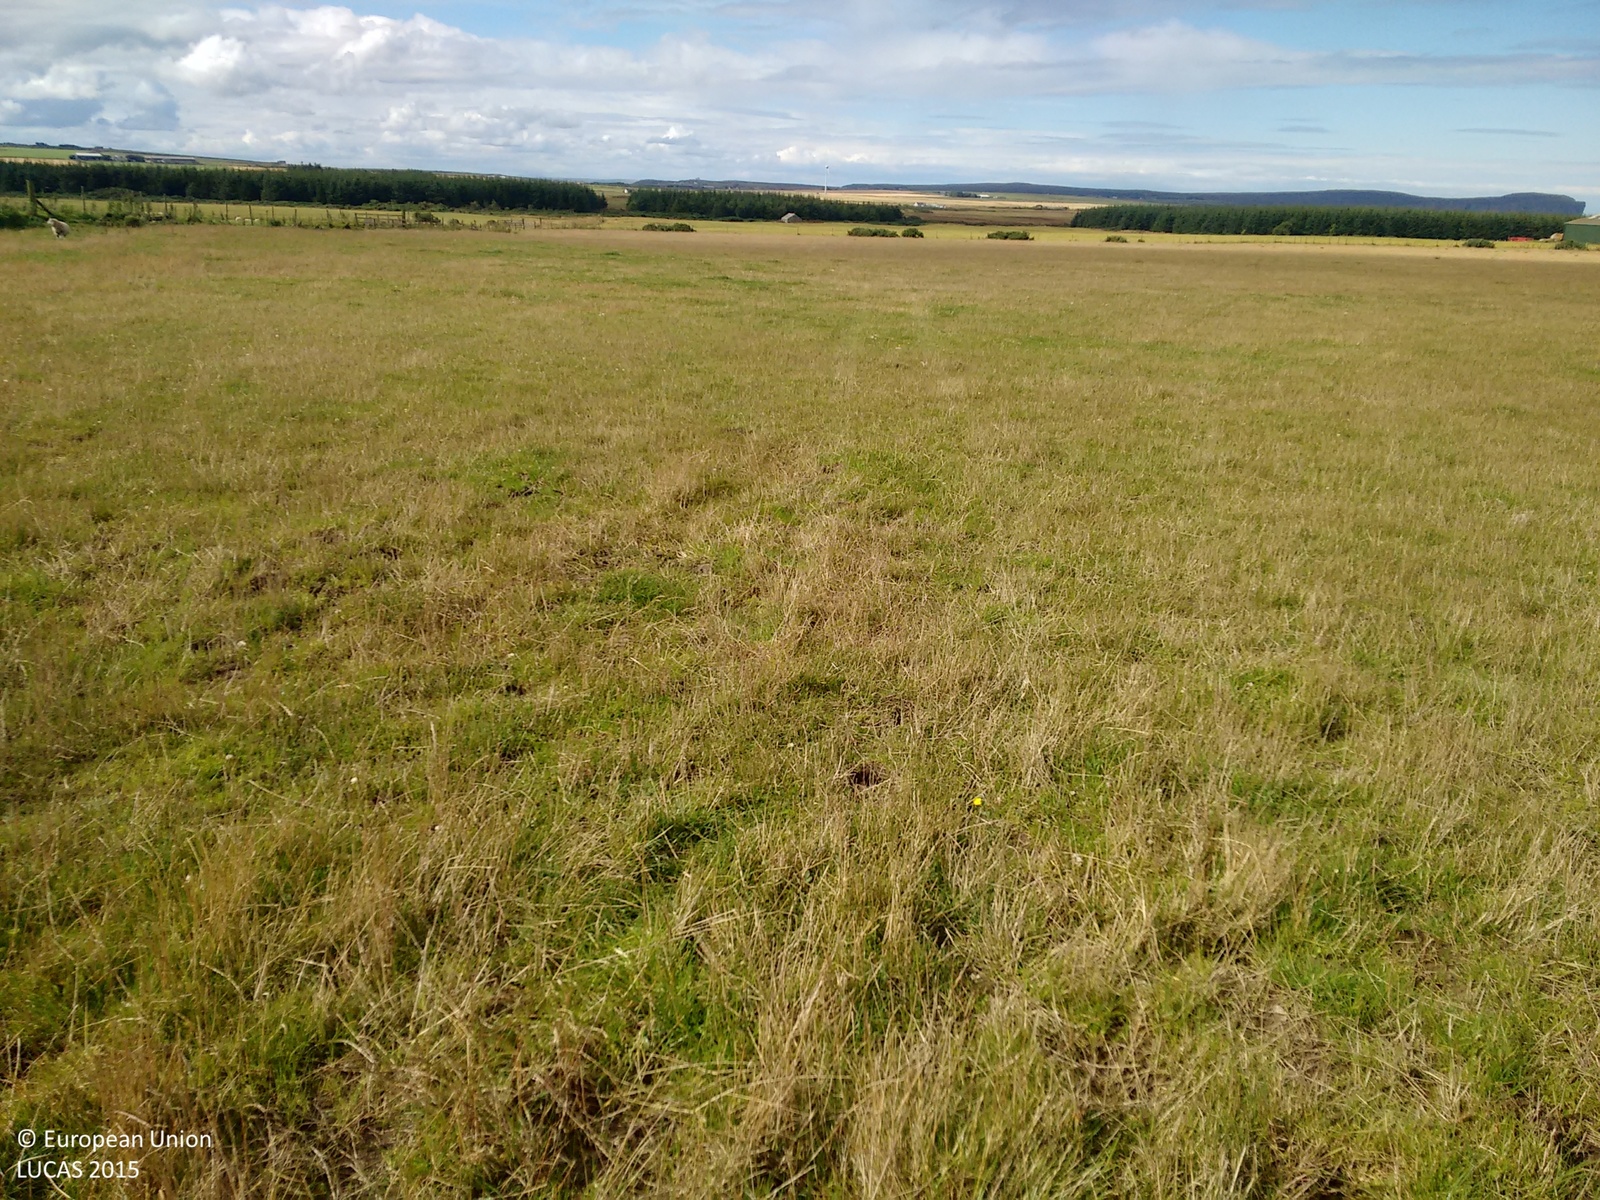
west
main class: Grassland
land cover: Grassland without tree/shrub cover
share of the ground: > 75 %
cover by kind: herbaceous plants 100 %
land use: Agriculture (excluding fallow land and kitchen gardens)
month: August
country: GB
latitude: 58.6388
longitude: -3.2378
